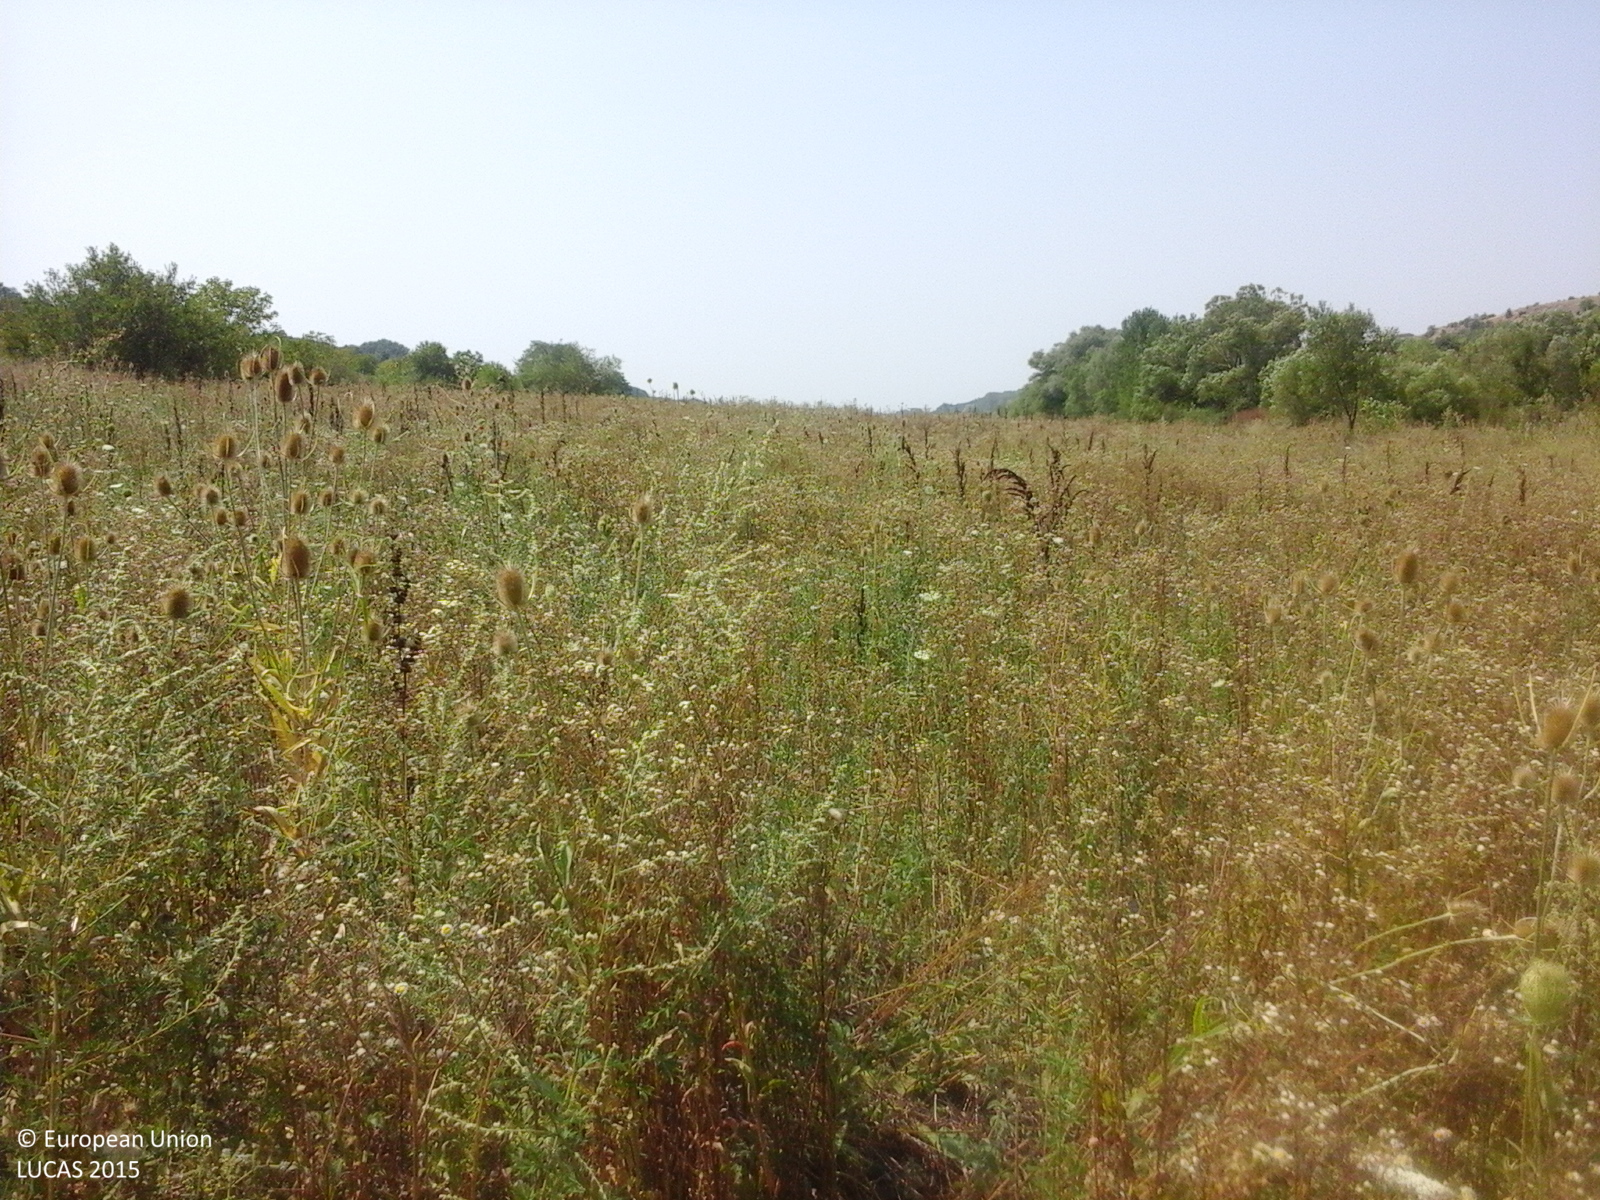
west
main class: Grassland
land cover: Spontaneously vegetated surfaces
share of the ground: > 75 %
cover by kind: herbaceous plants 100 %
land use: Fallow land
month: August
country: RO
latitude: 44.3971
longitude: 23.3456
